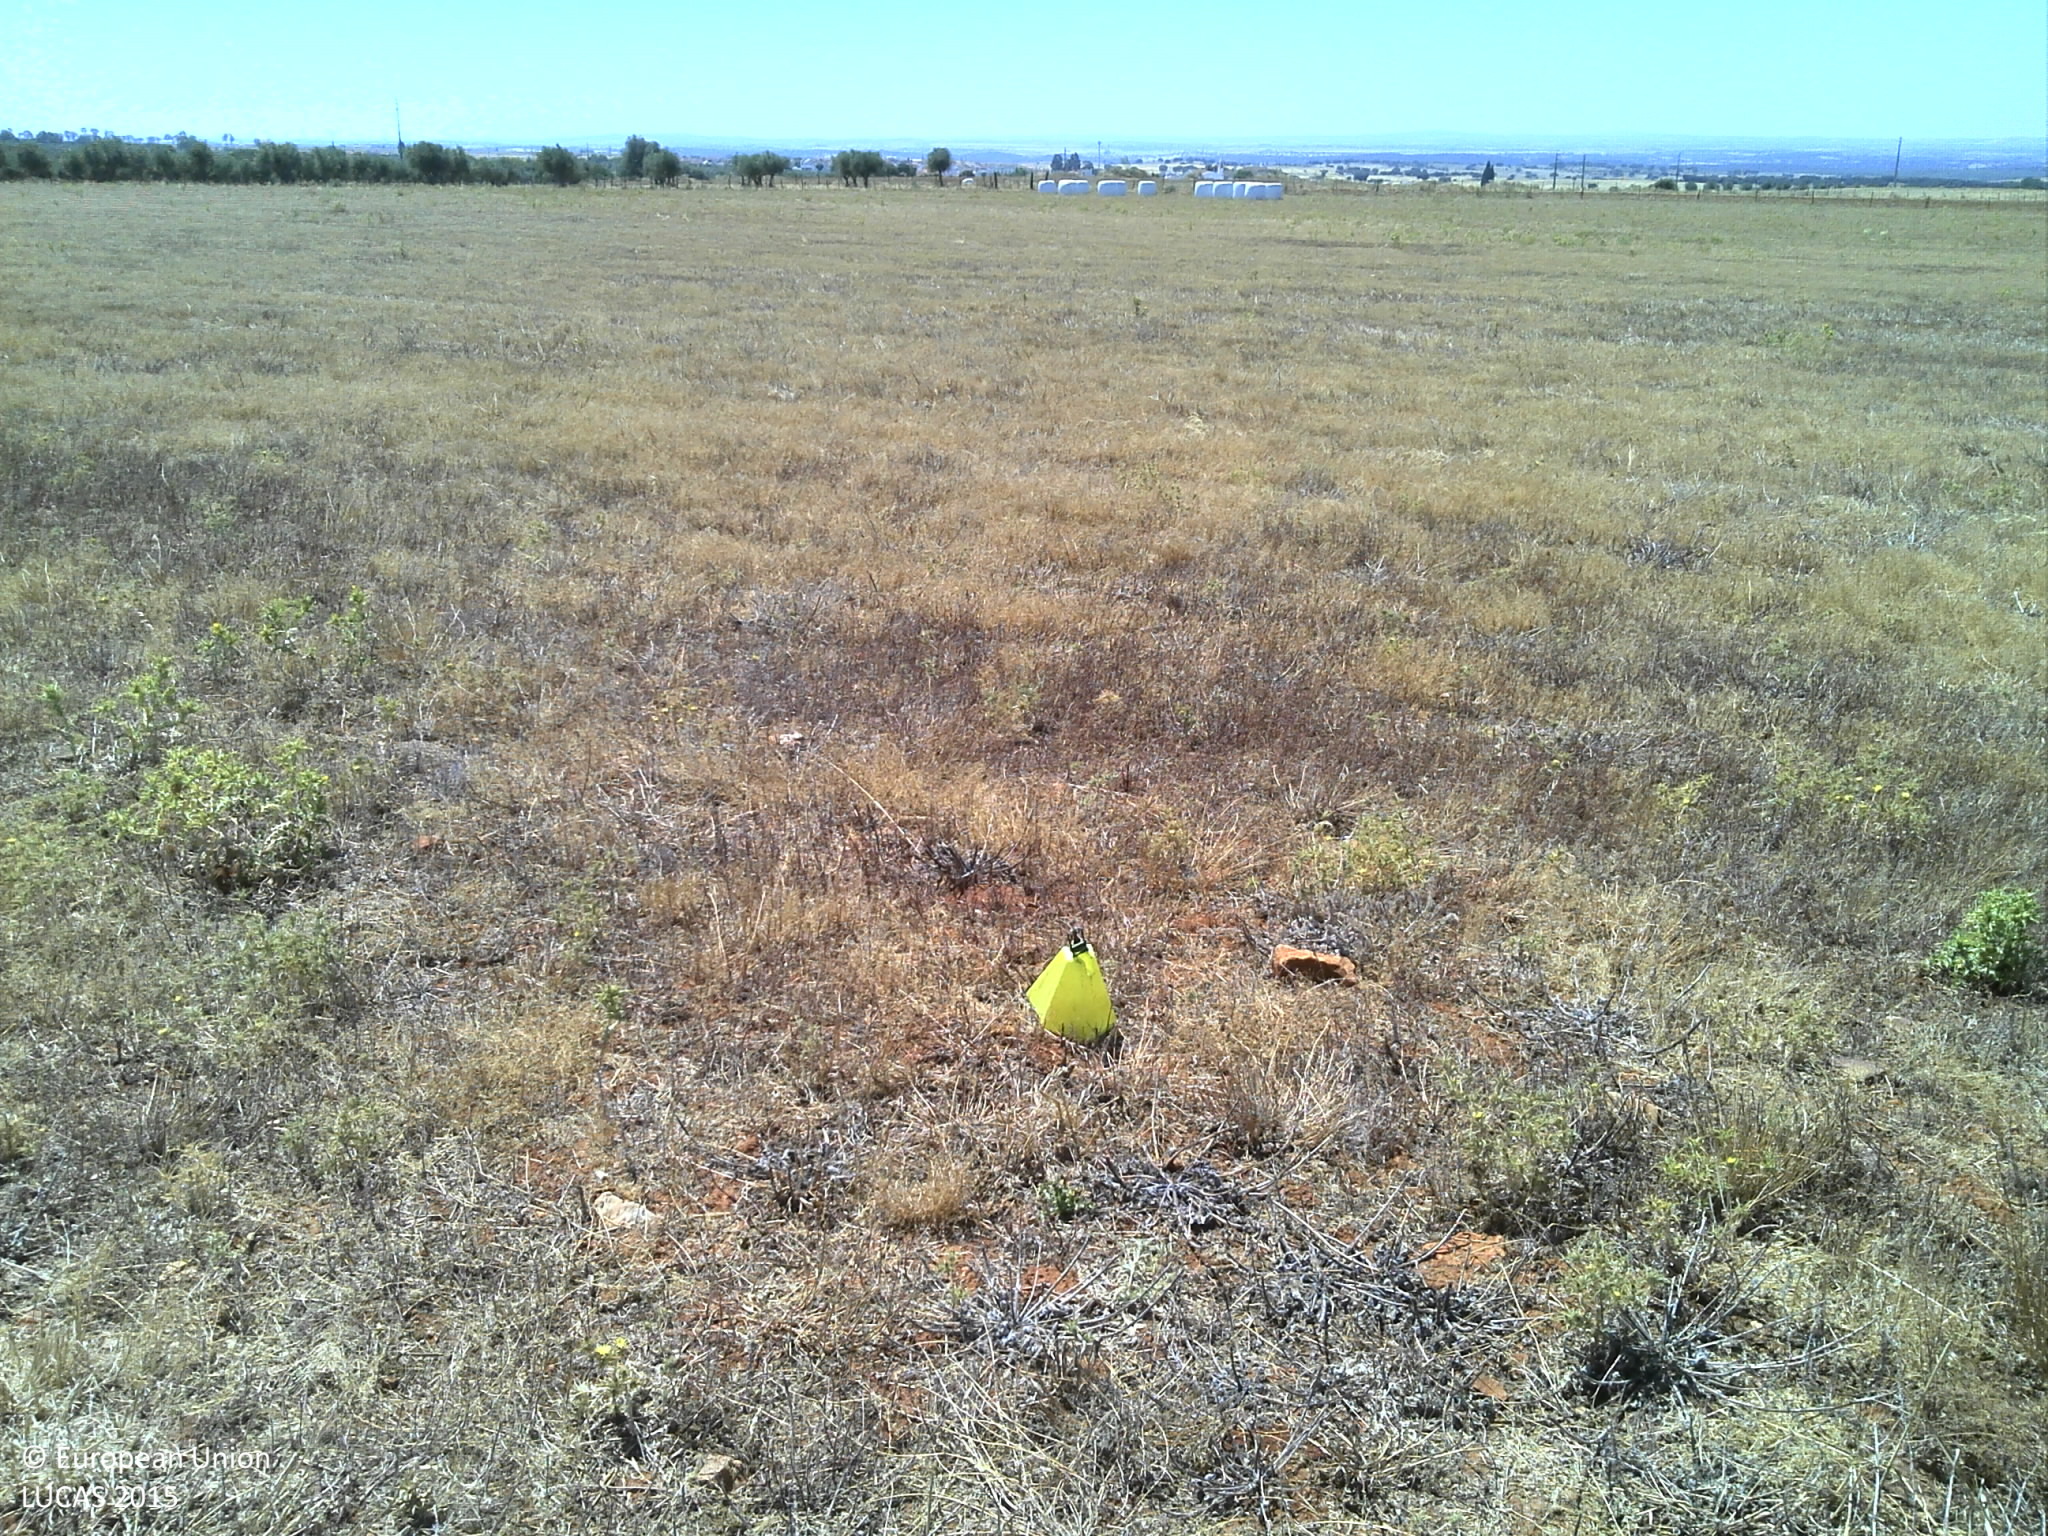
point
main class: Cropland
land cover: Temporary grasslands
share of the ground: 10 - 25 %
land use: Agriculture (excluding fallow land and kitchen gardens)
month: July
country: PT
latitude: 39.1030
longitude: -7.5124
